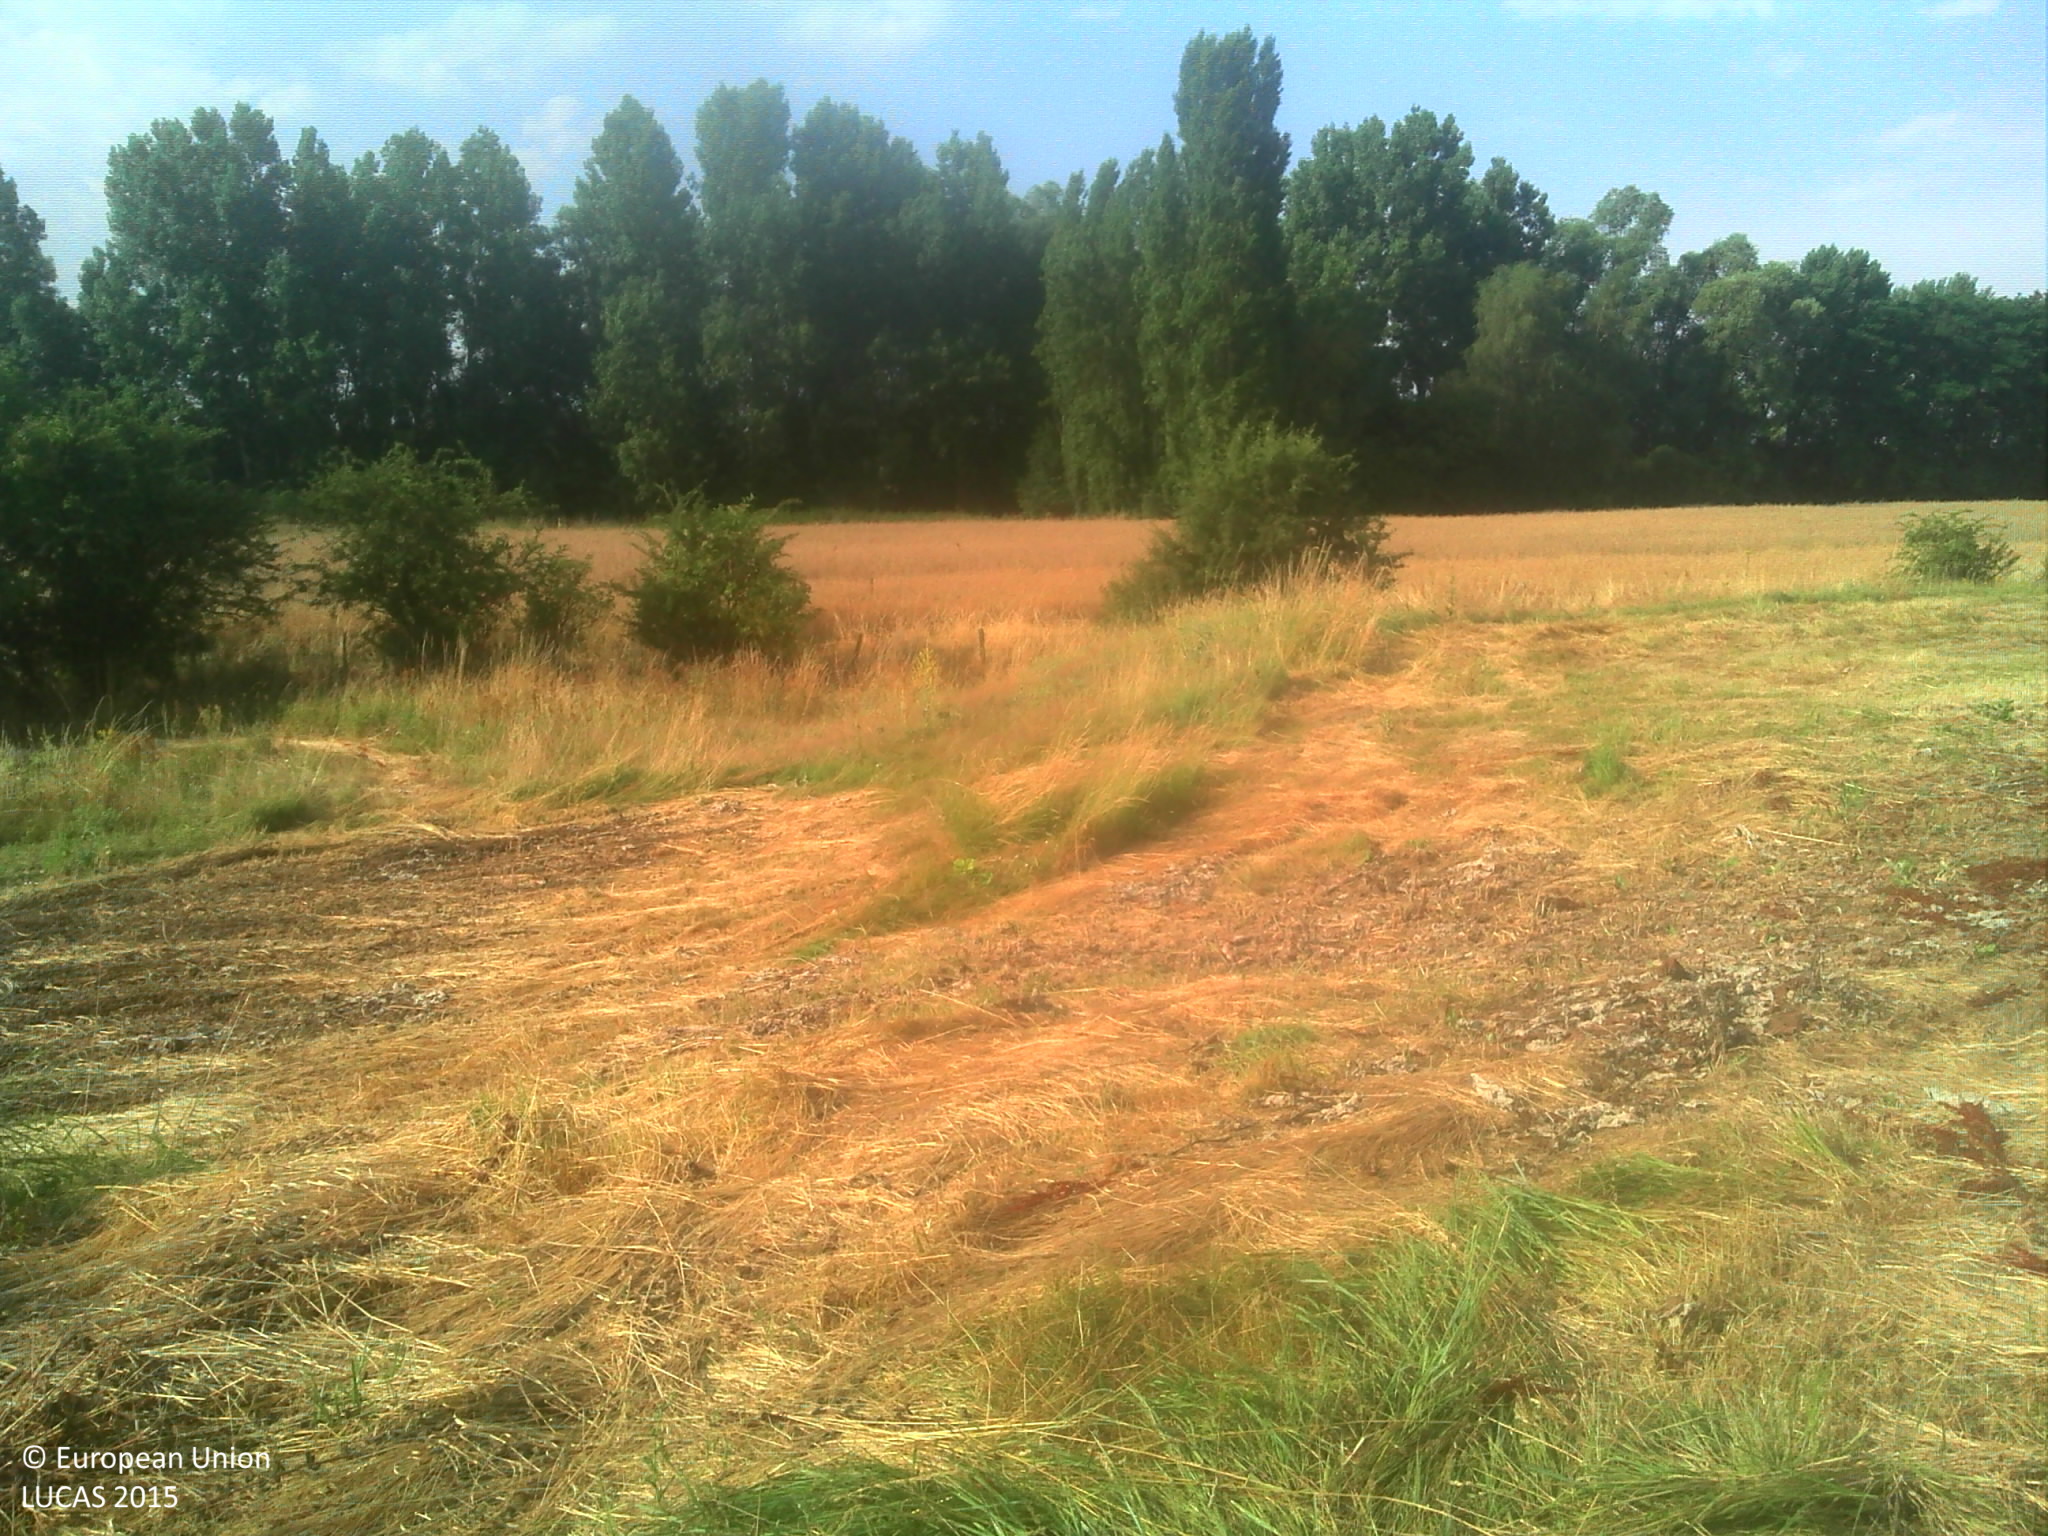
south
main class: Grassland
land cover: Grassland without tree/shrub cover
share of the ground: > 75 %
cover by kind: herbaceous plants 100 %
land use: Agriculture (excluding fallow land and kitchen gardens)
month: July
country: FR
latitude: 47.6557
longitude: 1.4507
